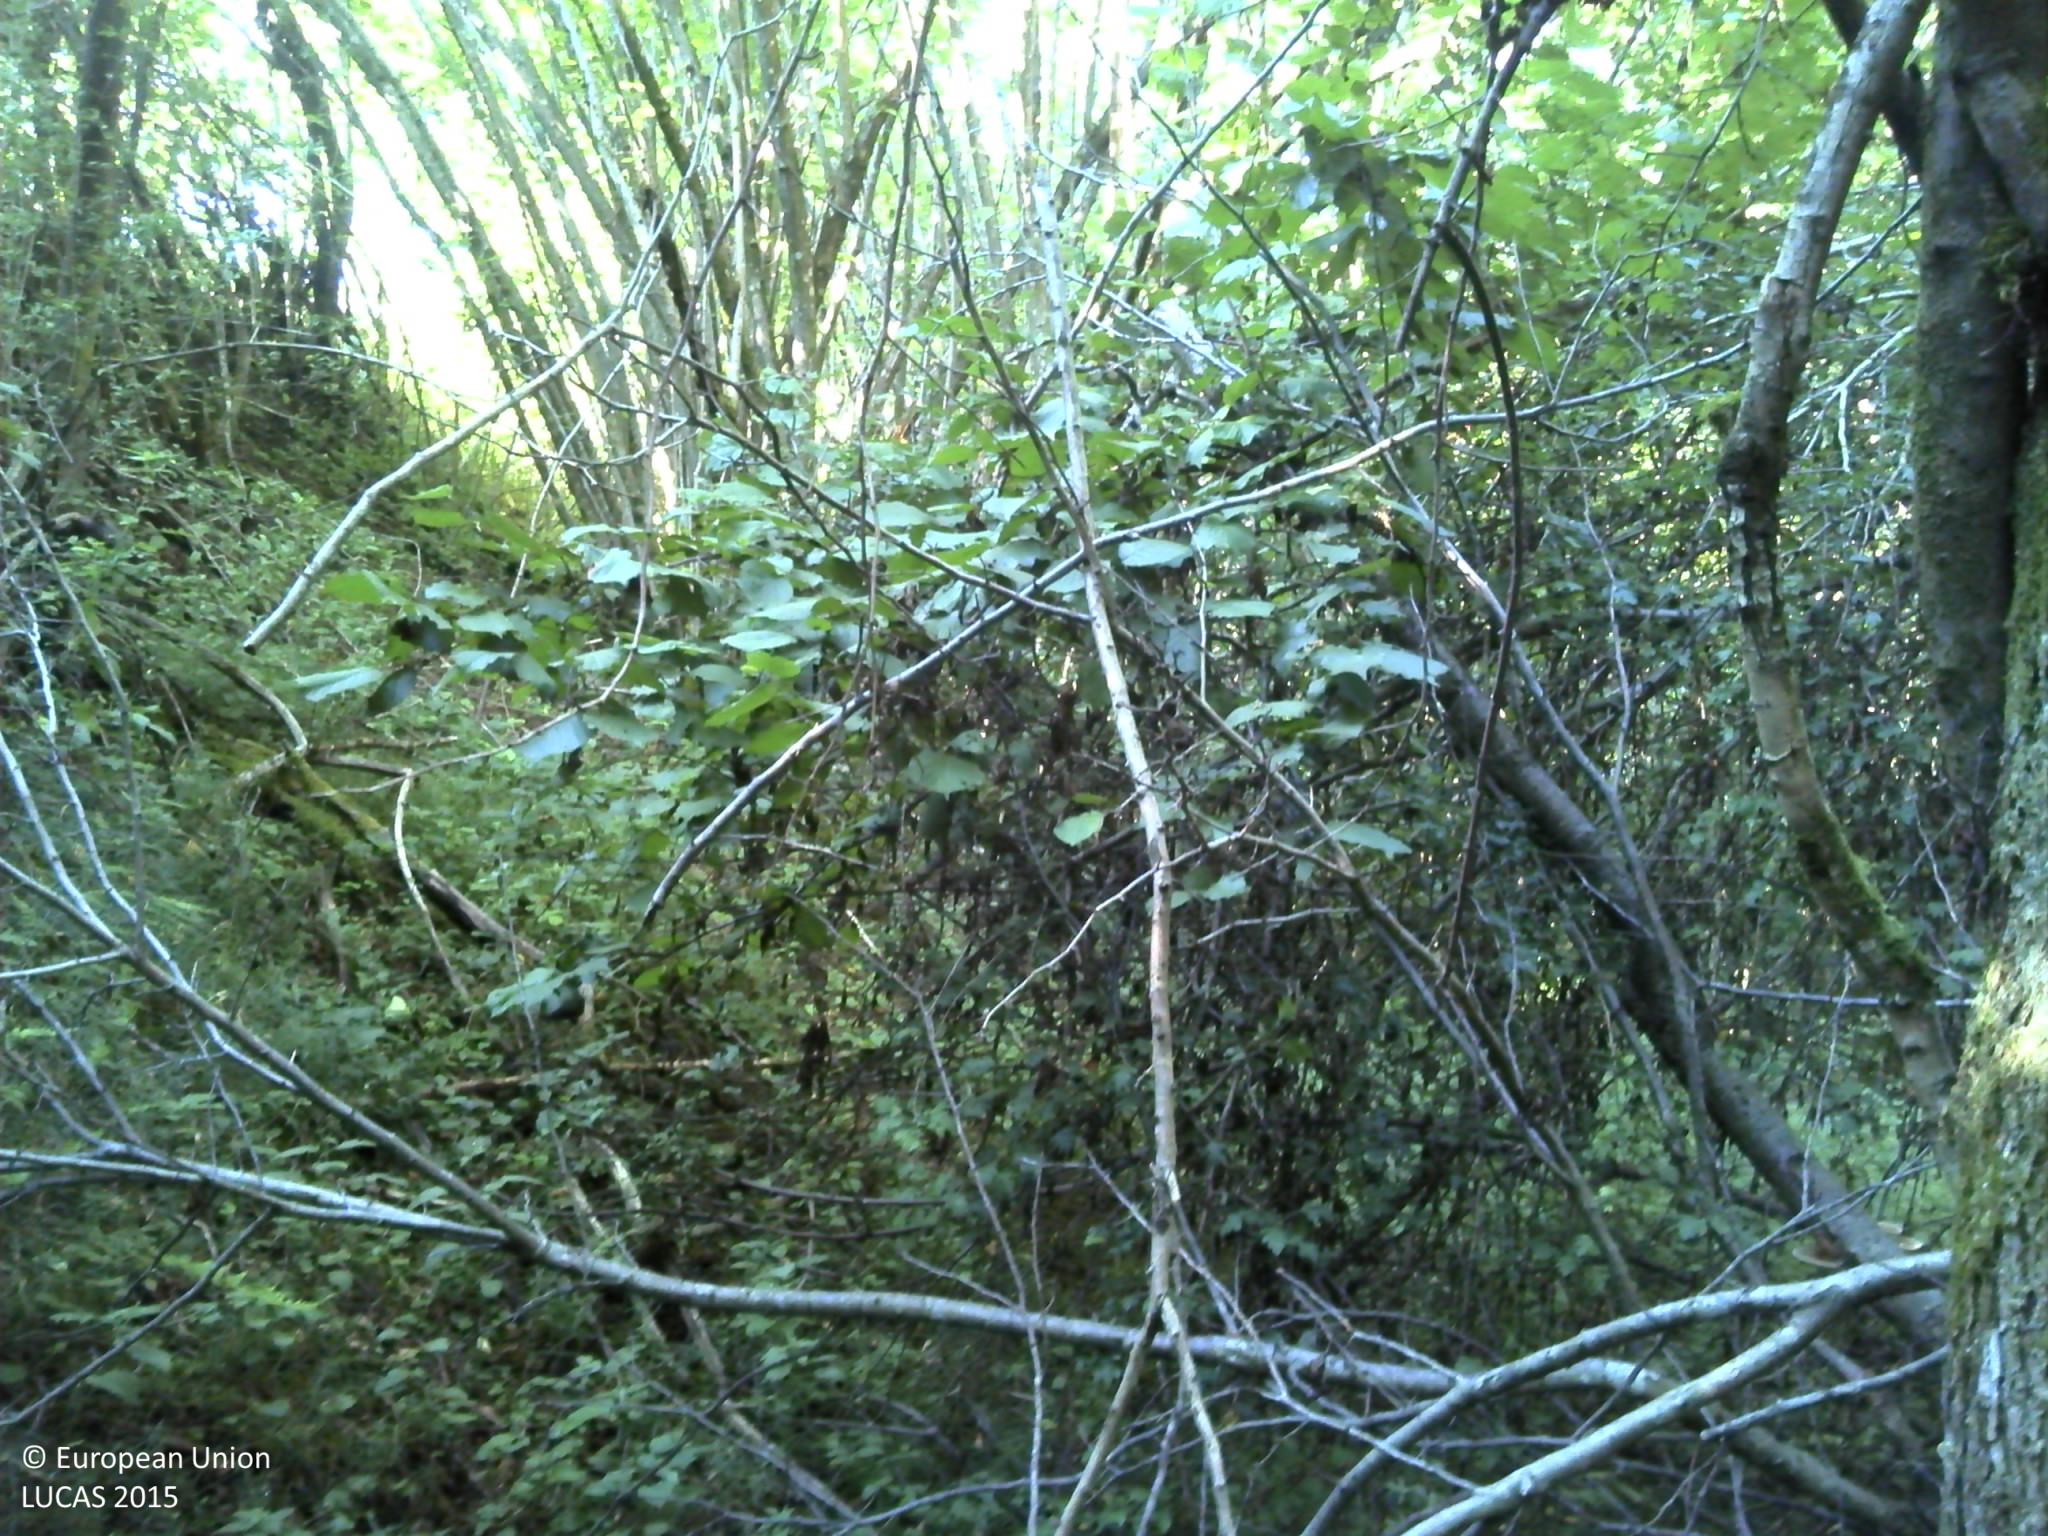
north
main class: Woodland
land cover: Broadleaved woodland
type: beech forest
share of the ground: > 75 %
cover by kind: broadleaved forest trees 100 %
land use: Forestry
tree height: > 5 m
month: August
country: HR
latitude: 45.1165
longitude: 16.3142
